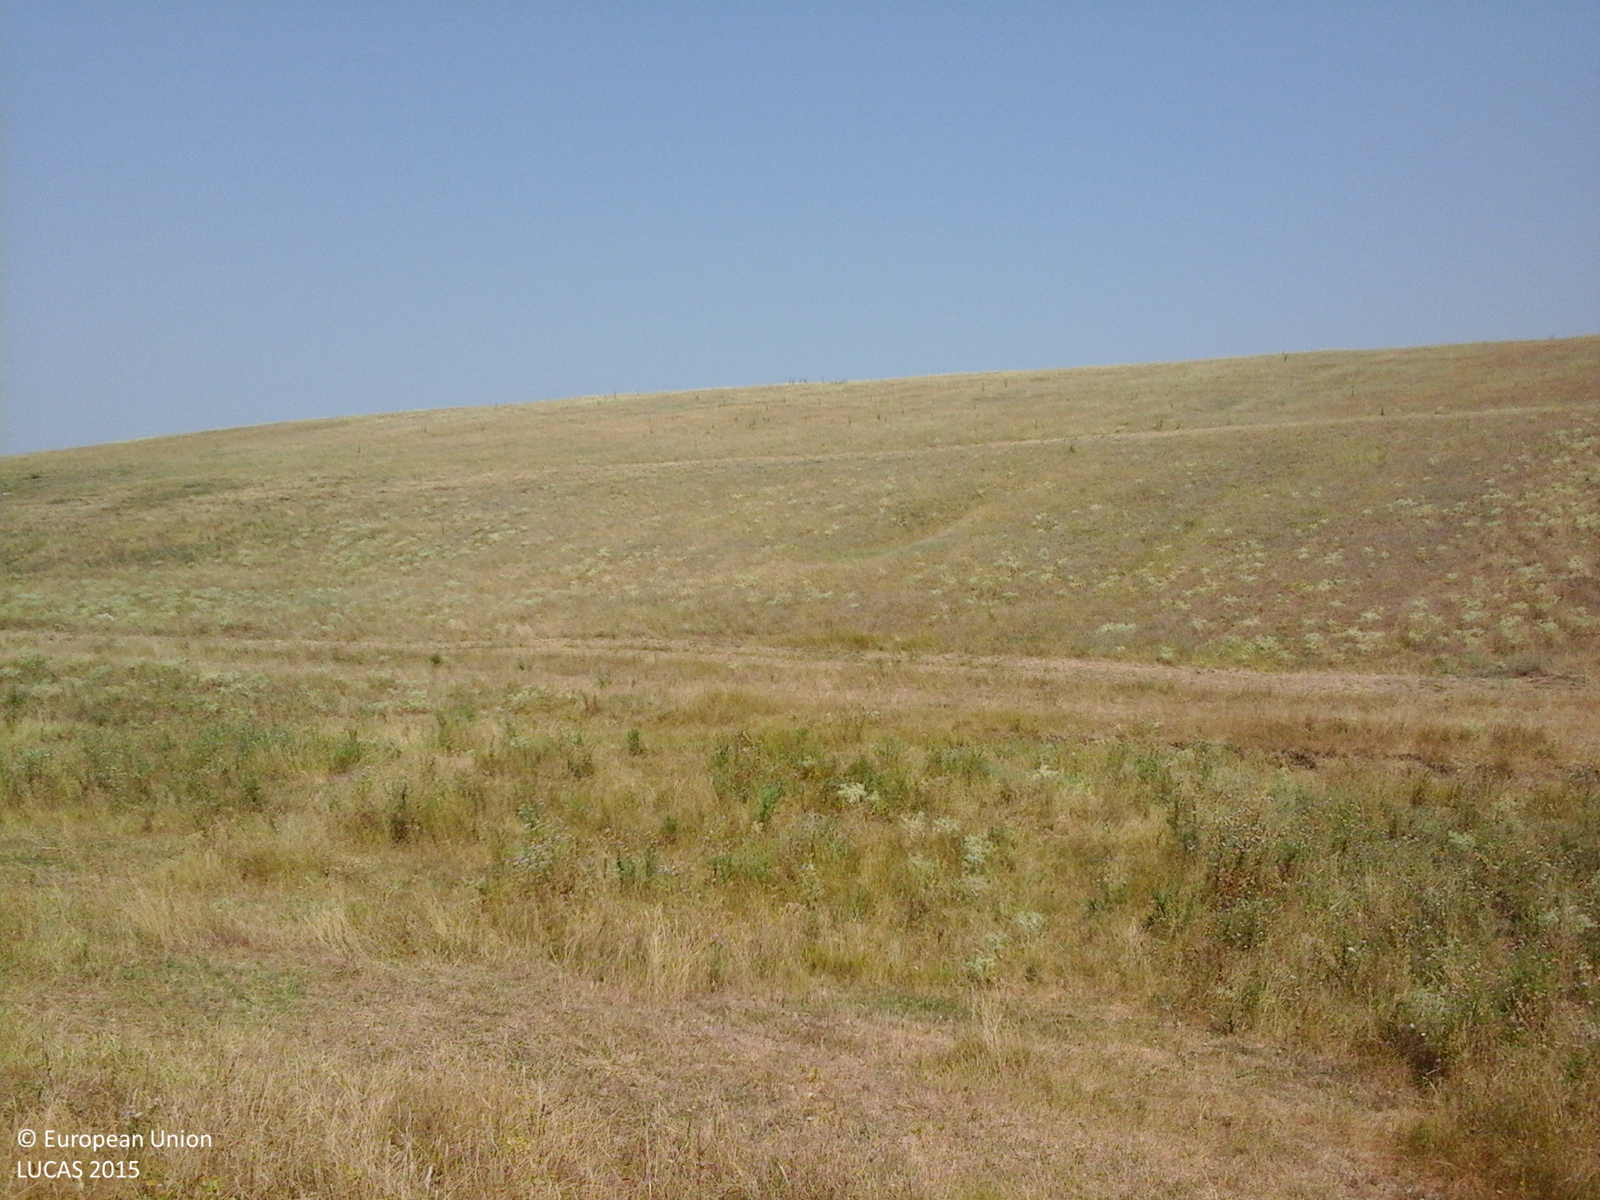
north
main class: Grassland
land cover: Grassland without tree/shrub cover
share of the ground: > 75 %
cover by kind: herbaceous plants 100 %
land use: Agriculture (excluding fallow land and kitchen gardens)
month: August
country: RO
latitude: 44.3776
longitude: 23.2135
